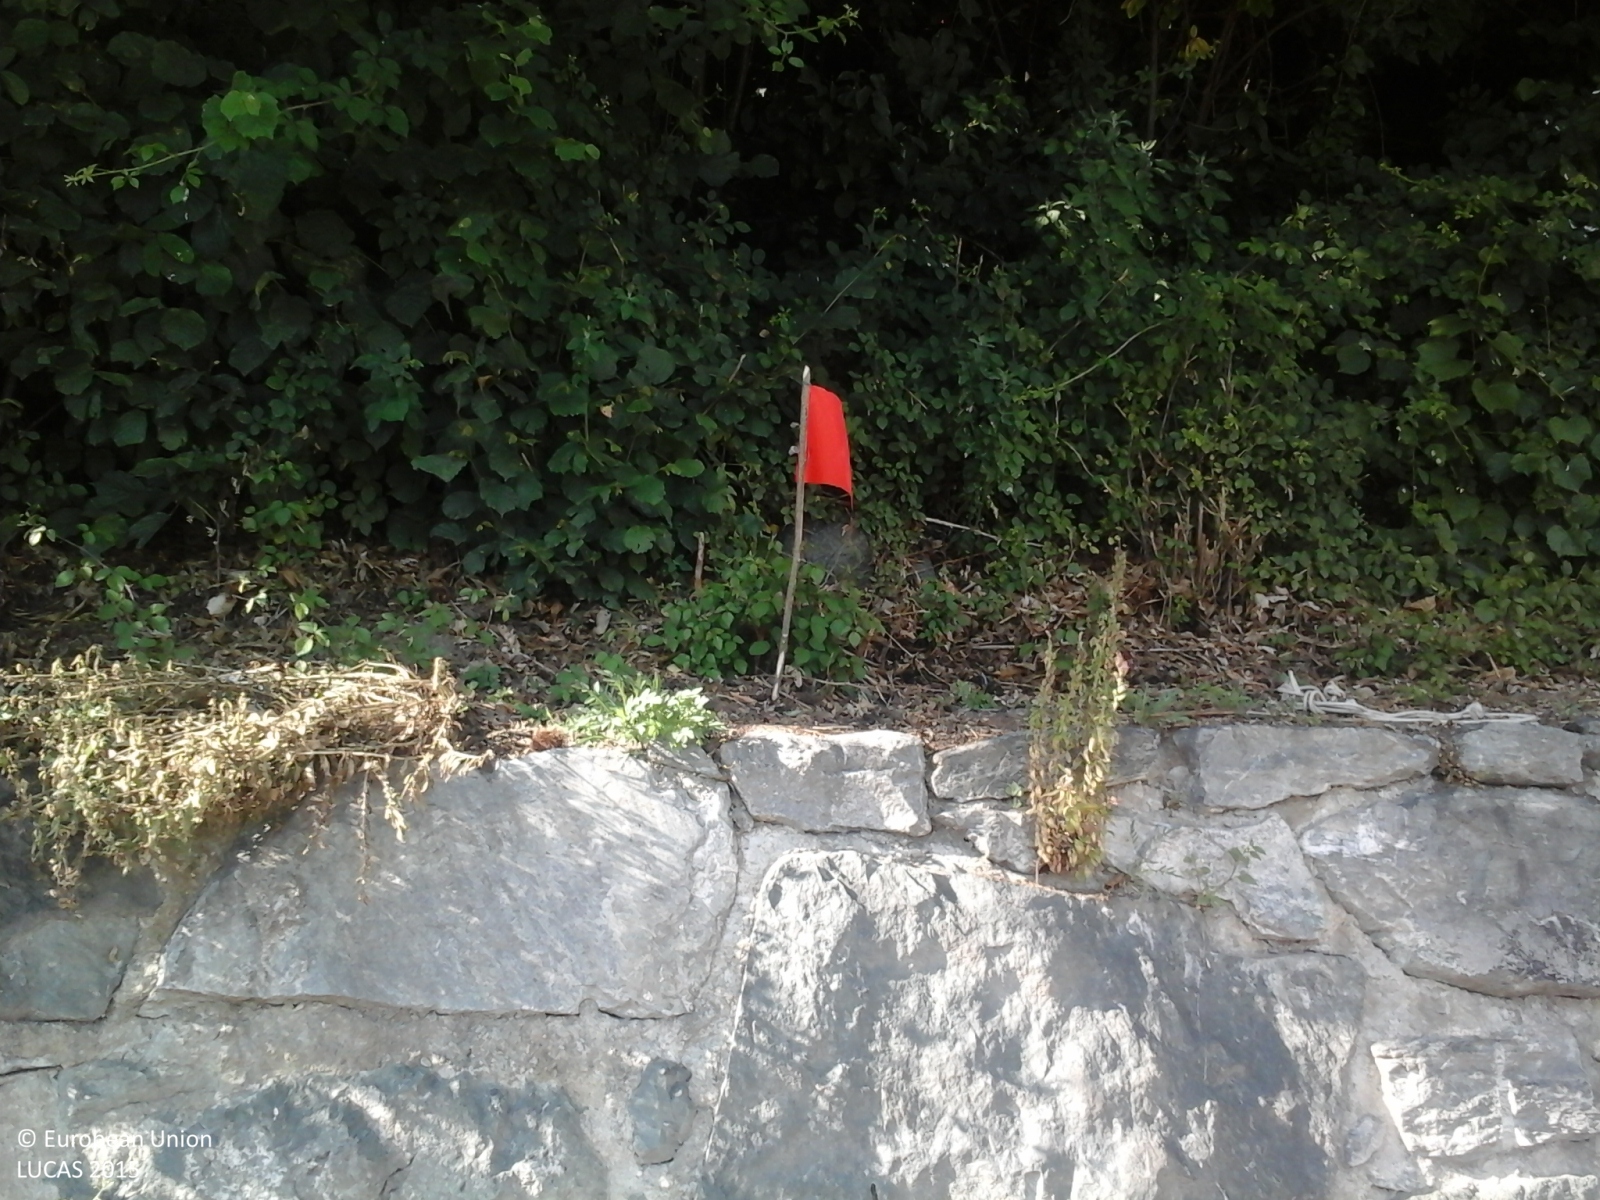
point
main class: Woodland
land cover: Broadleaved woodland
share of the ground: > 75 %
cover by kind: broadleaved forest trees 100 %
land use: Forestry
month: June
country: IT
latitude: 45.7313
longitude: 7.6774
